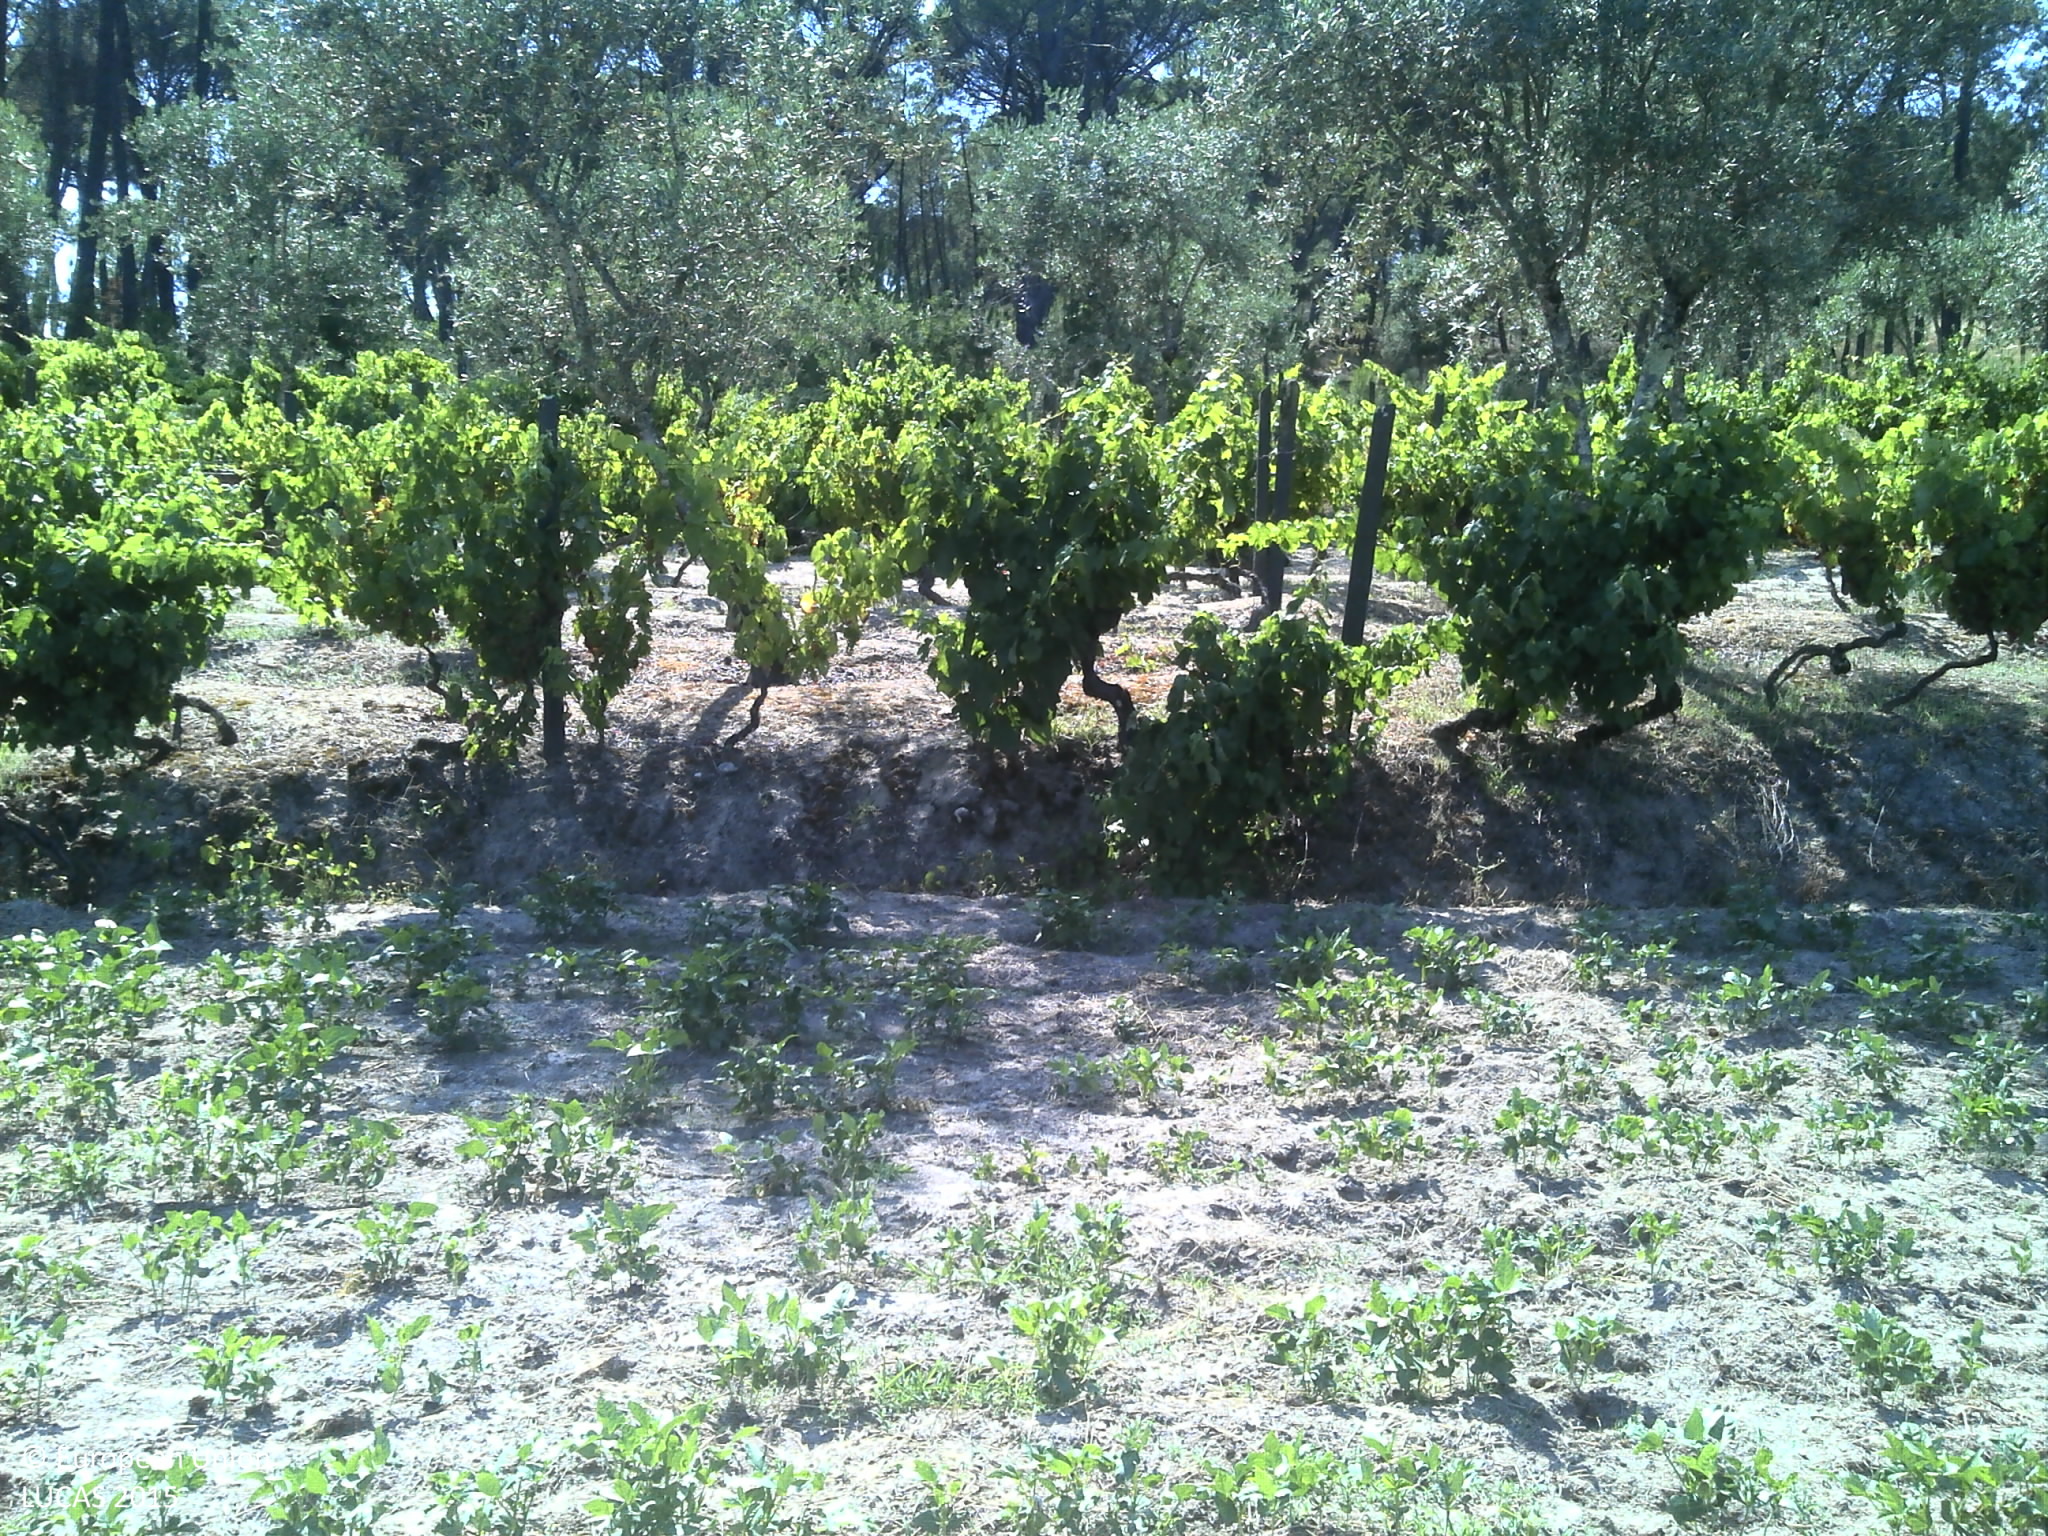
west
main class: Cropland
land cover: Dry pulses
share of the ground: 25 - 50 %
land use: Agriculture (excluding fallow land and kitchen gardens)
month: June
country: PT
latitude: 40.5251
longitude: -7.9109
